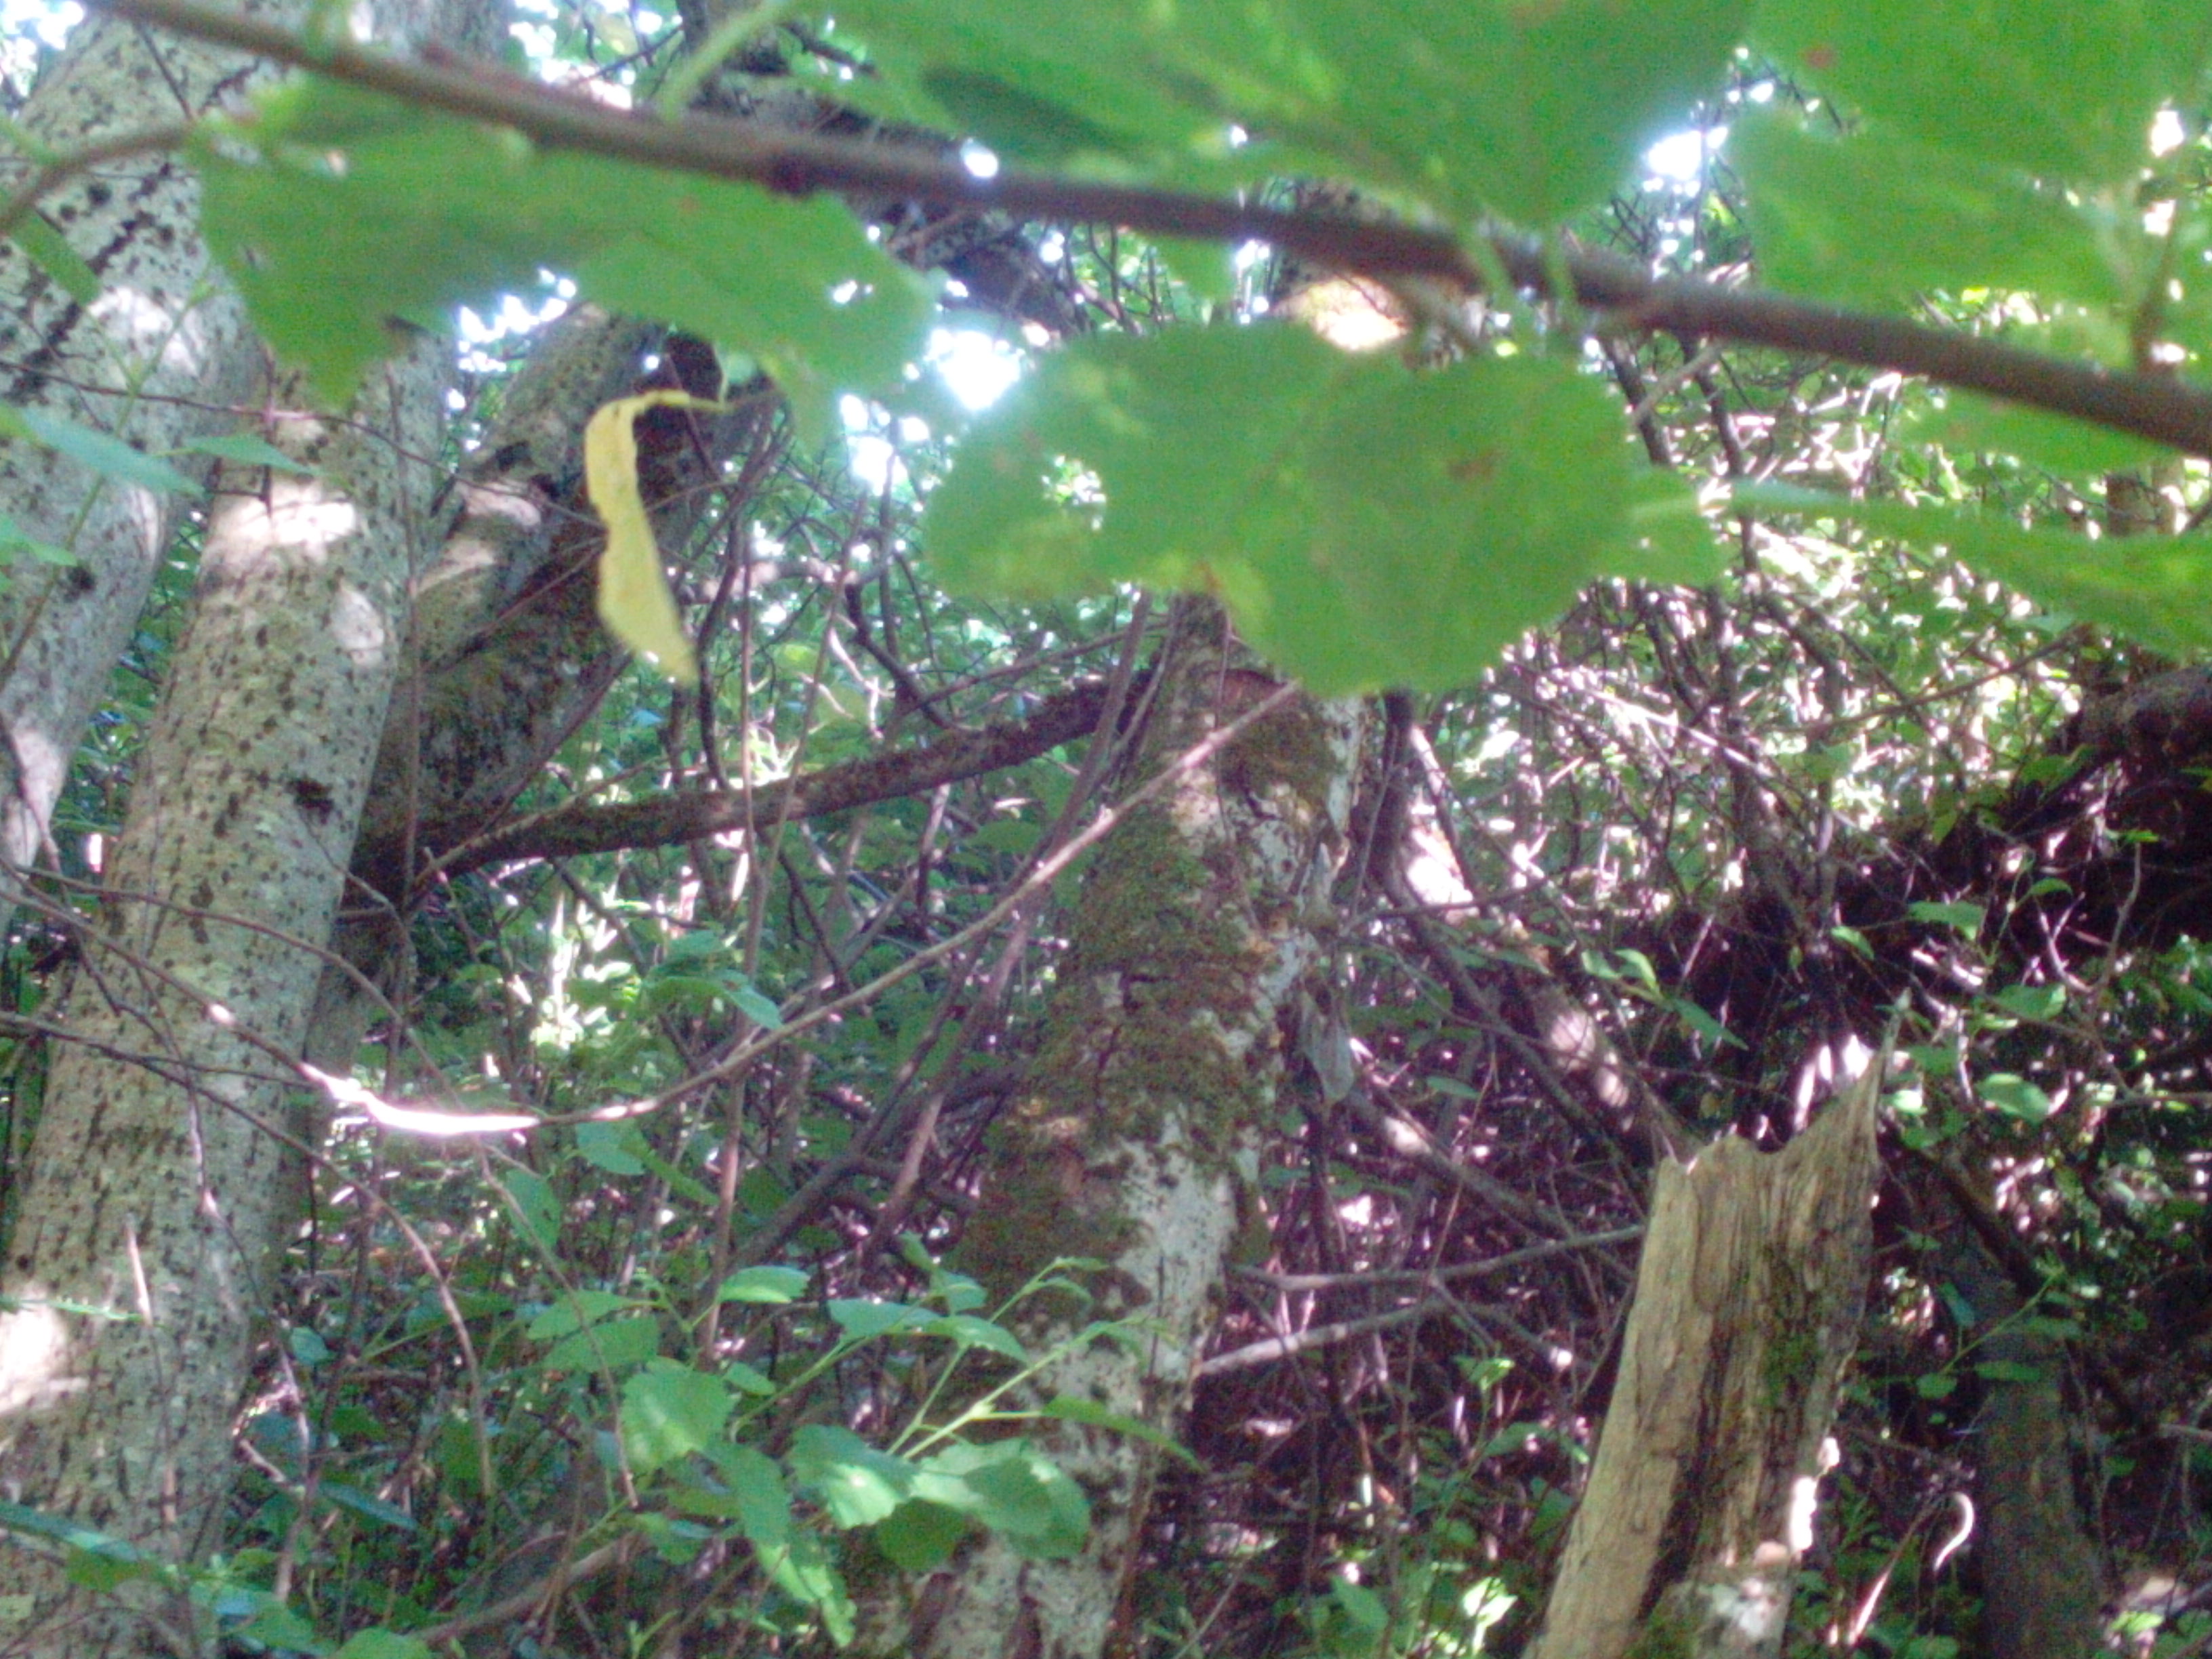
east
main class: Woodland
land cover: Broadleaved woodland
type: non-riverine alder, birch or aspen forest
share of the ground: > 75 %
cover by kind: broadleaved forest trees 80 %, herbaceous plants 20 %
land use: Forestry
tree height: > 5 m
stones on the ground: < 10 %
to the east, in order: Broadleaved woodland; Common wheat; Shruby margins; Ditches and canals; Shruby margins; Paved roads, cycling and walking lanes; Shruby margins; Ditches and canals; Abandoned hedges; Single bushes/trees; Grassland without tree/shrub cover; Common wheat
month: July
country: LV
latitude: 56.5495
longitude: 22.2034
